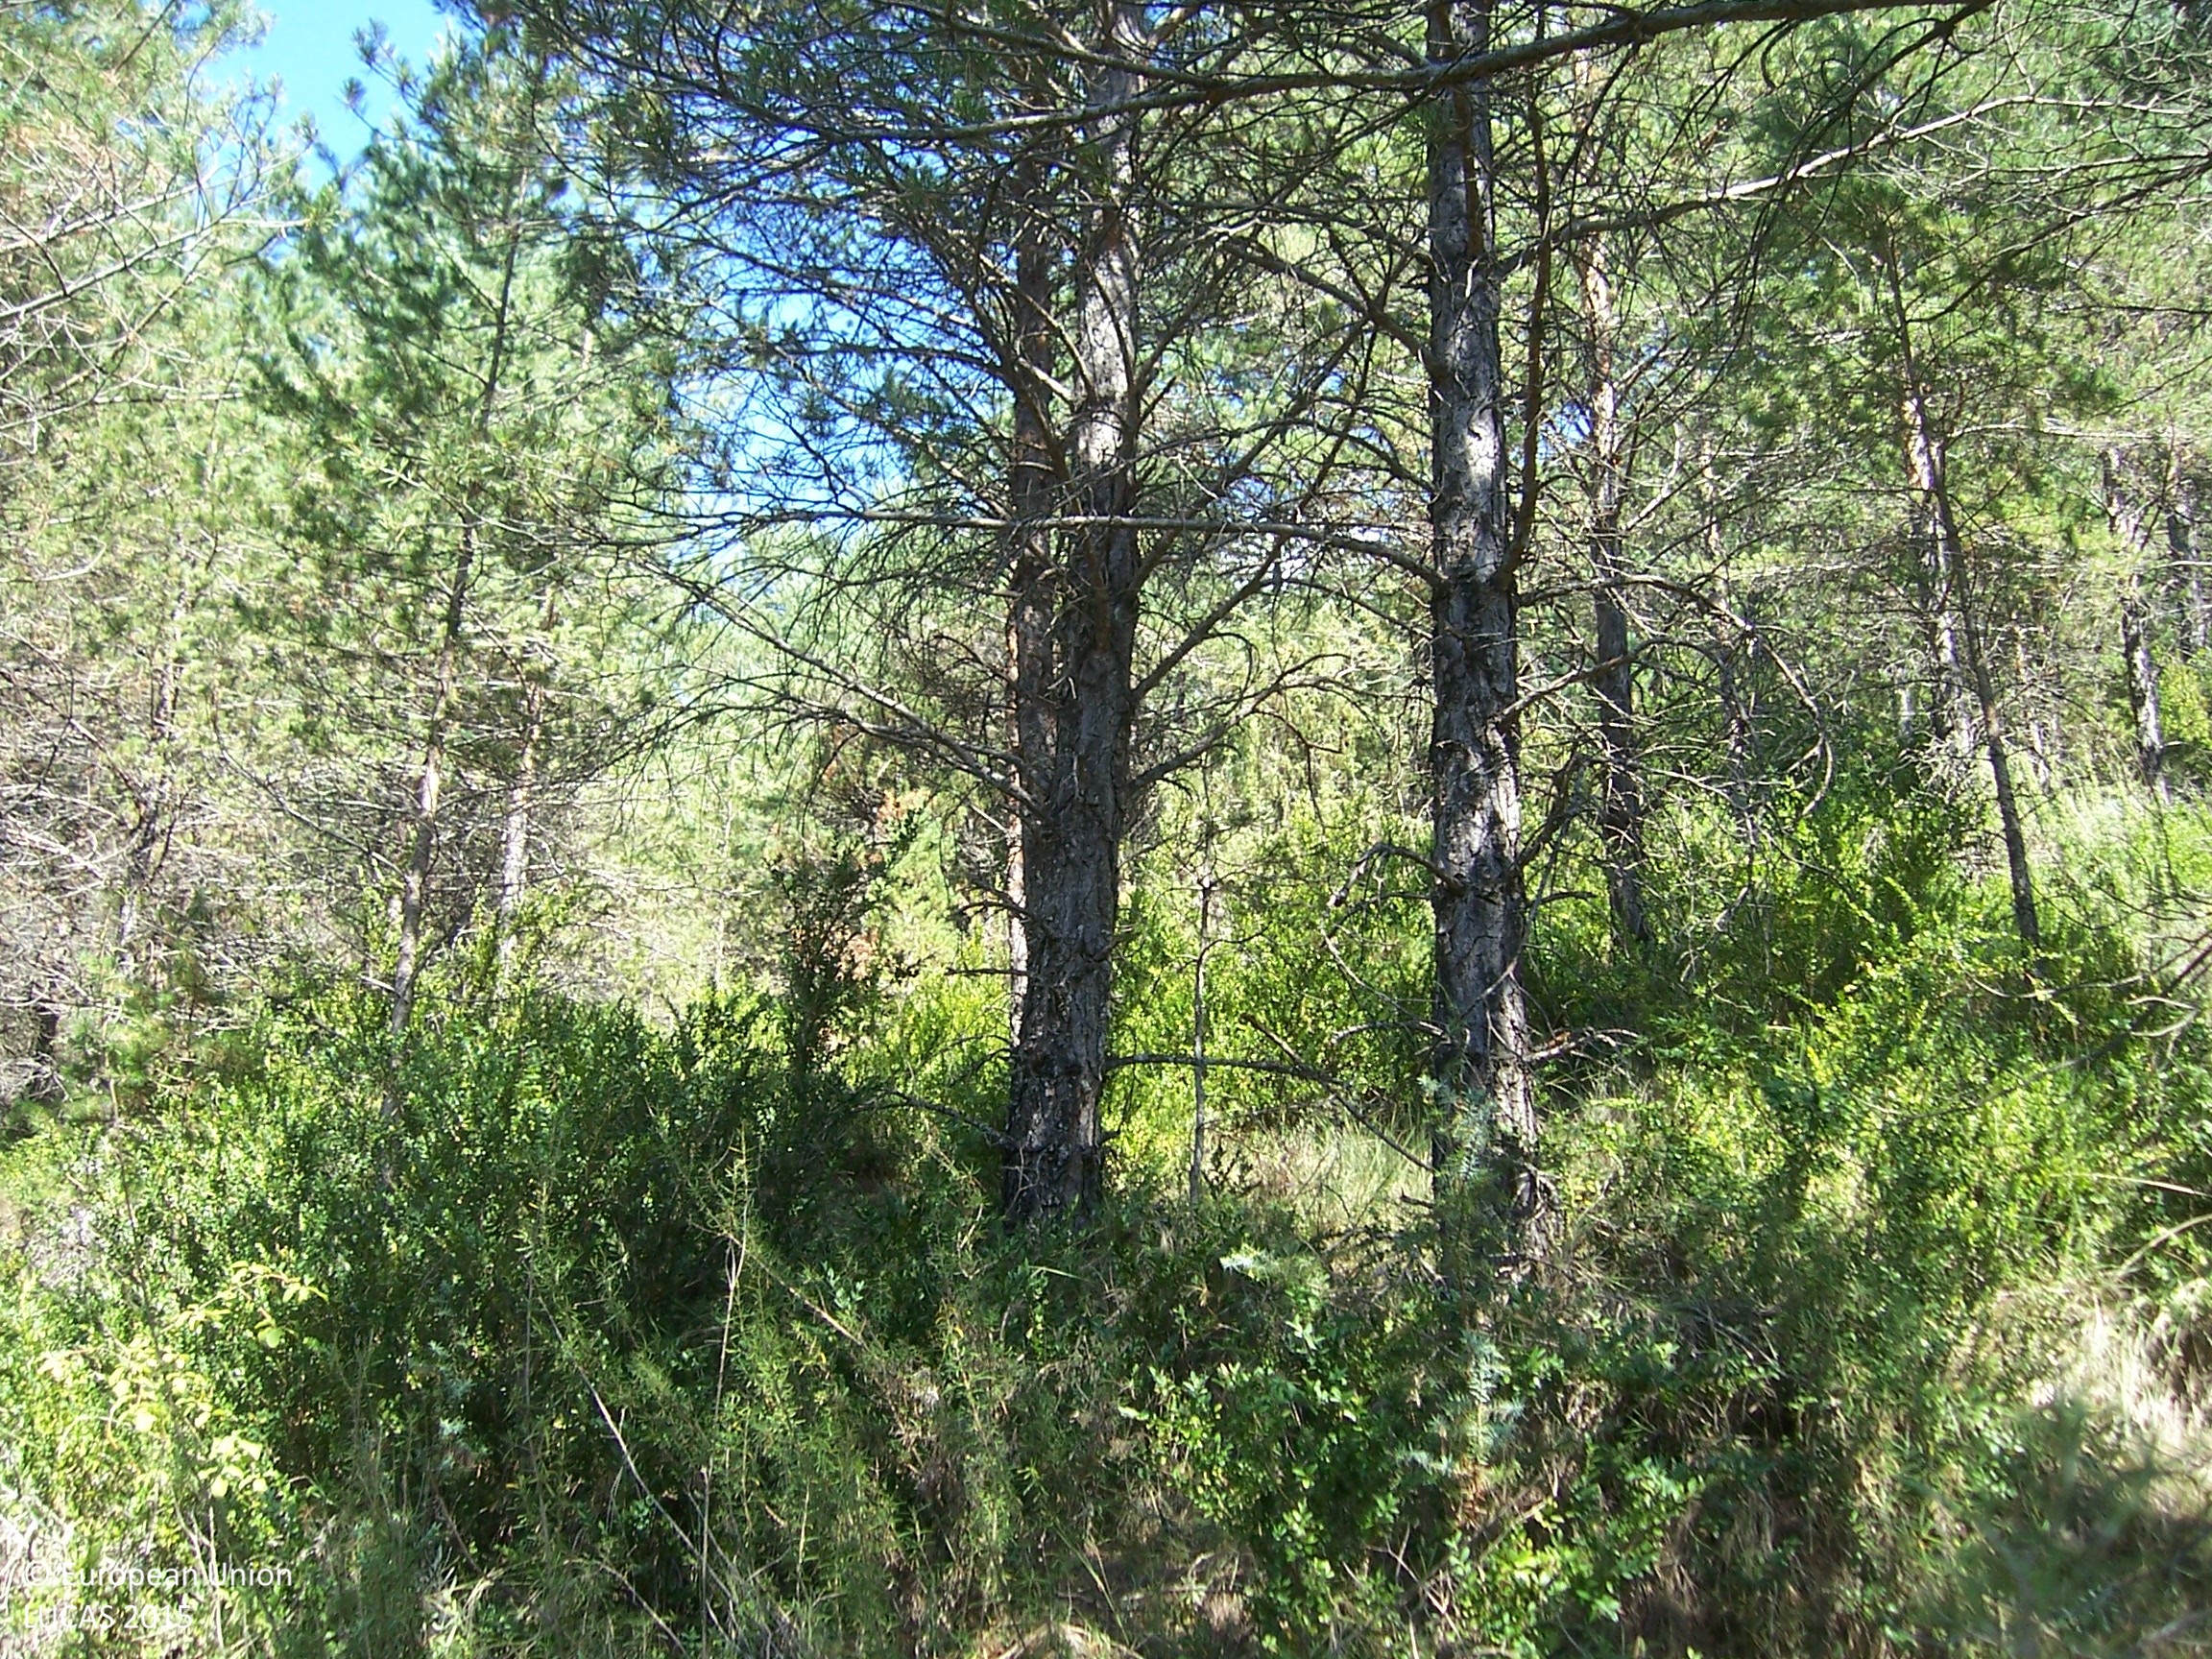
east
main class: Woodland
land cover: Pine dominated coniferous woodland
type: coniferous forest of the mediterranean region
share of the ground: > 75 %
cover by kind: coniferous forest trees 95 %, shrubs 5 %
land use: Forestry
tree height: > 5 m
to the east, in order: Pine dominated coniferous woodland
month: August
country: ES
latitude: 42.3336
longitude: 0.3078
